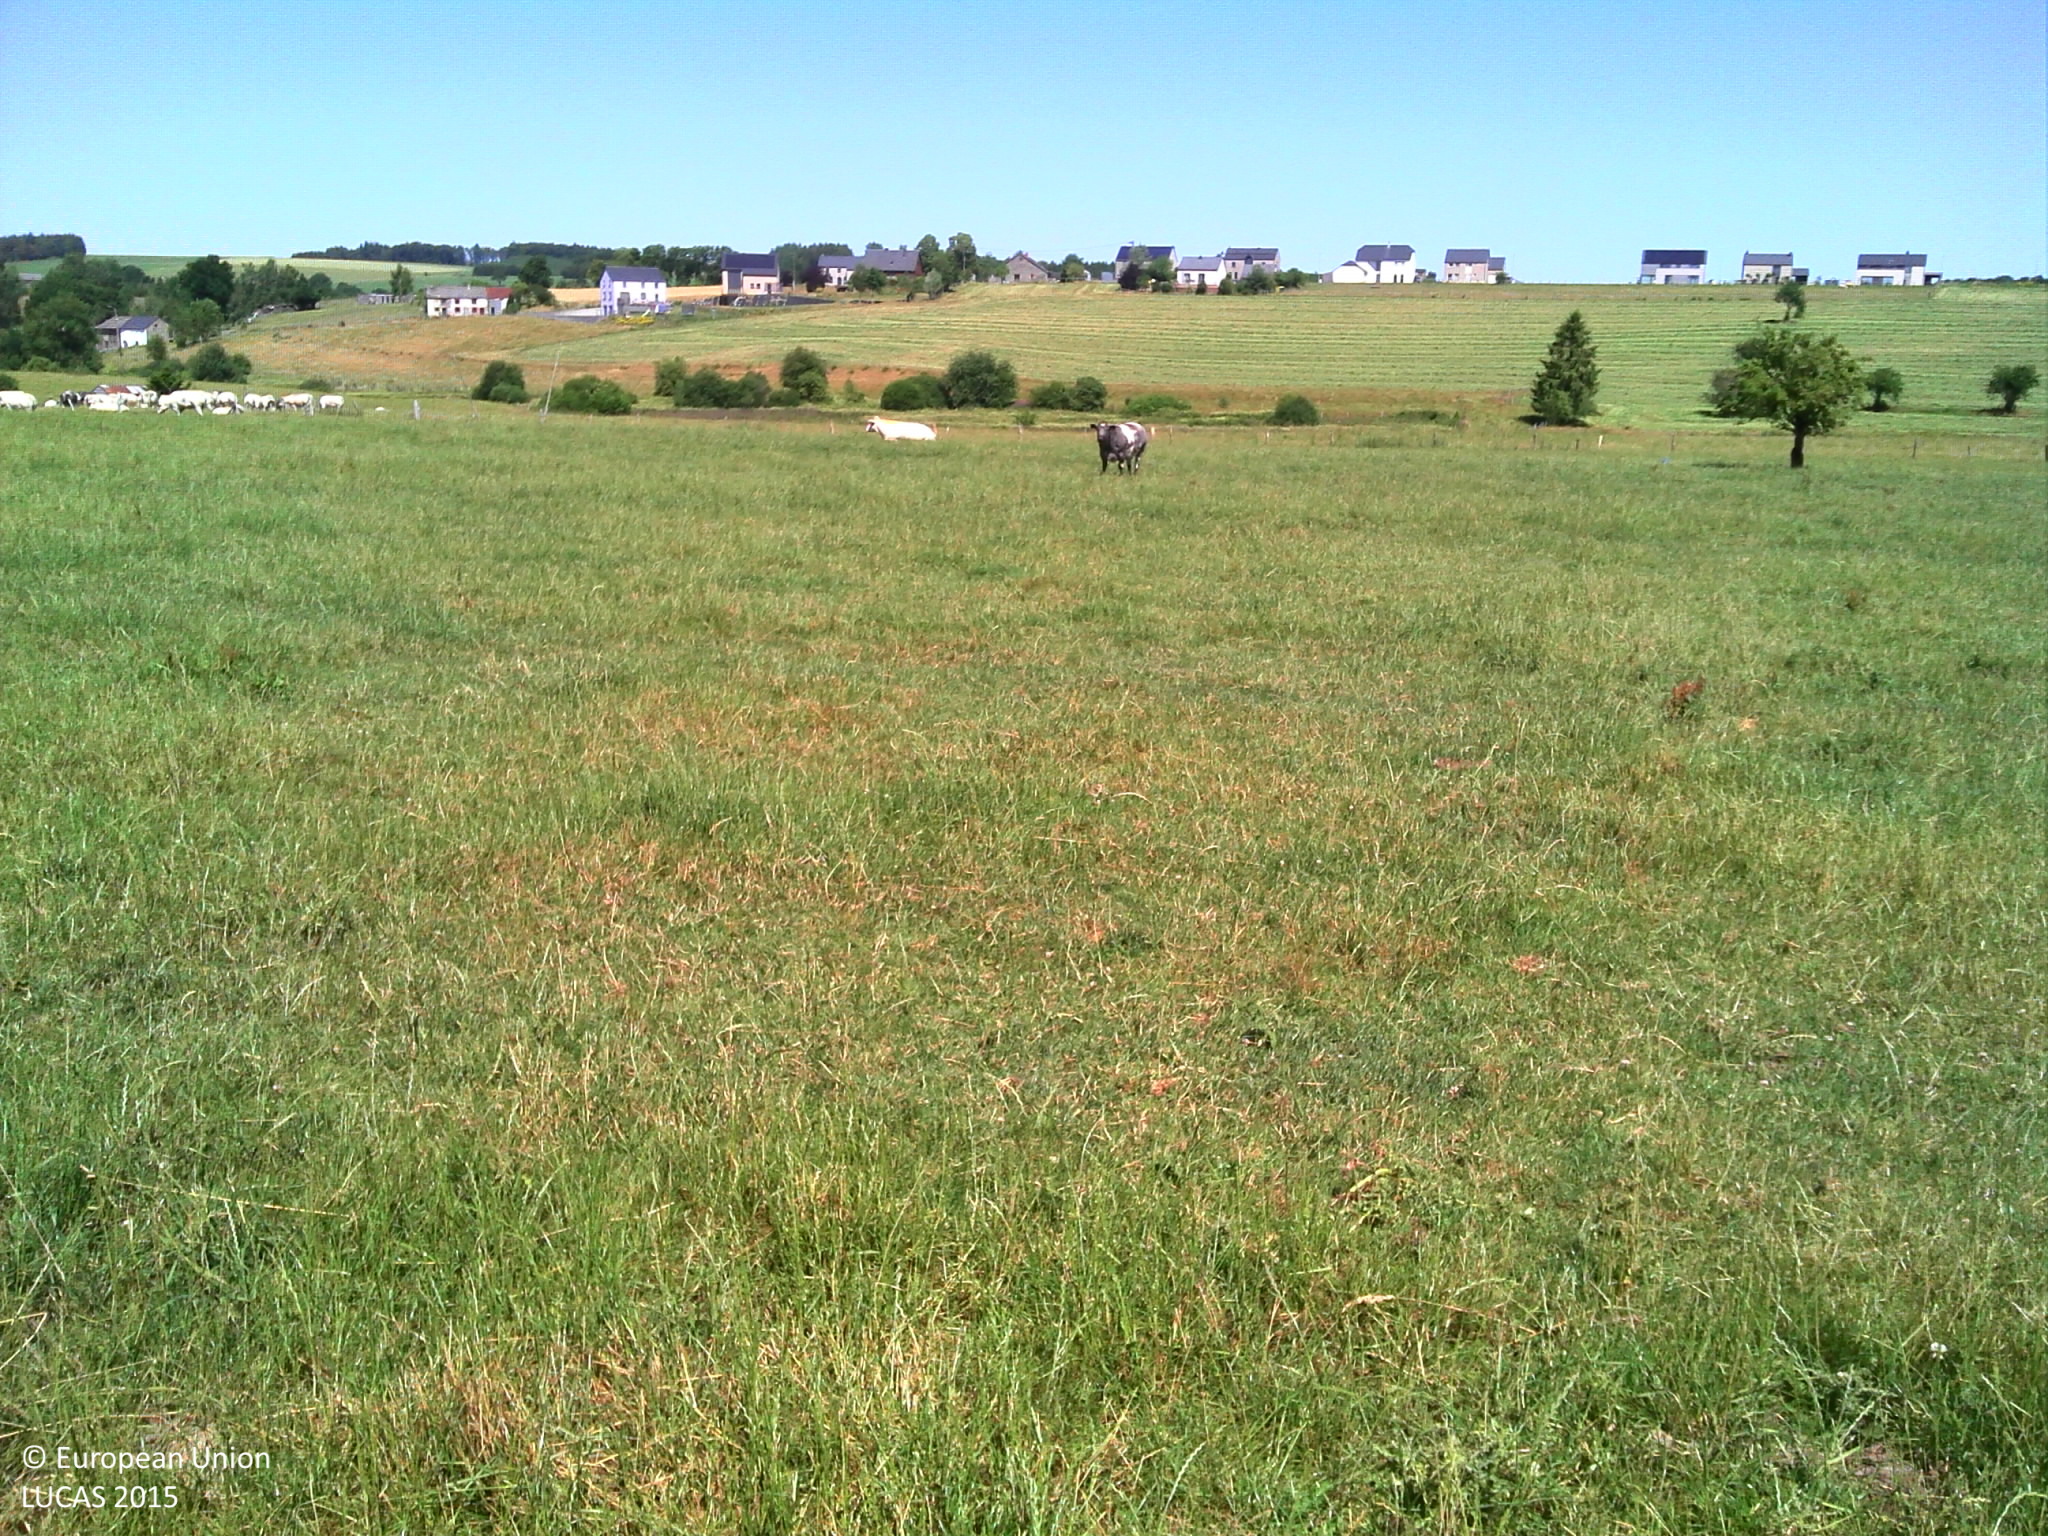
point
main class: Grassland
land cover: Grassland without tree/shrub cover
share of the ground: > 75 %
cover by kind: herbaceous plants 100 %
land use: Agriculture (excluding fallow land and kitchen gardens)
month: July
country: BE
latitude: 50.0844
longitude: 5.6801
